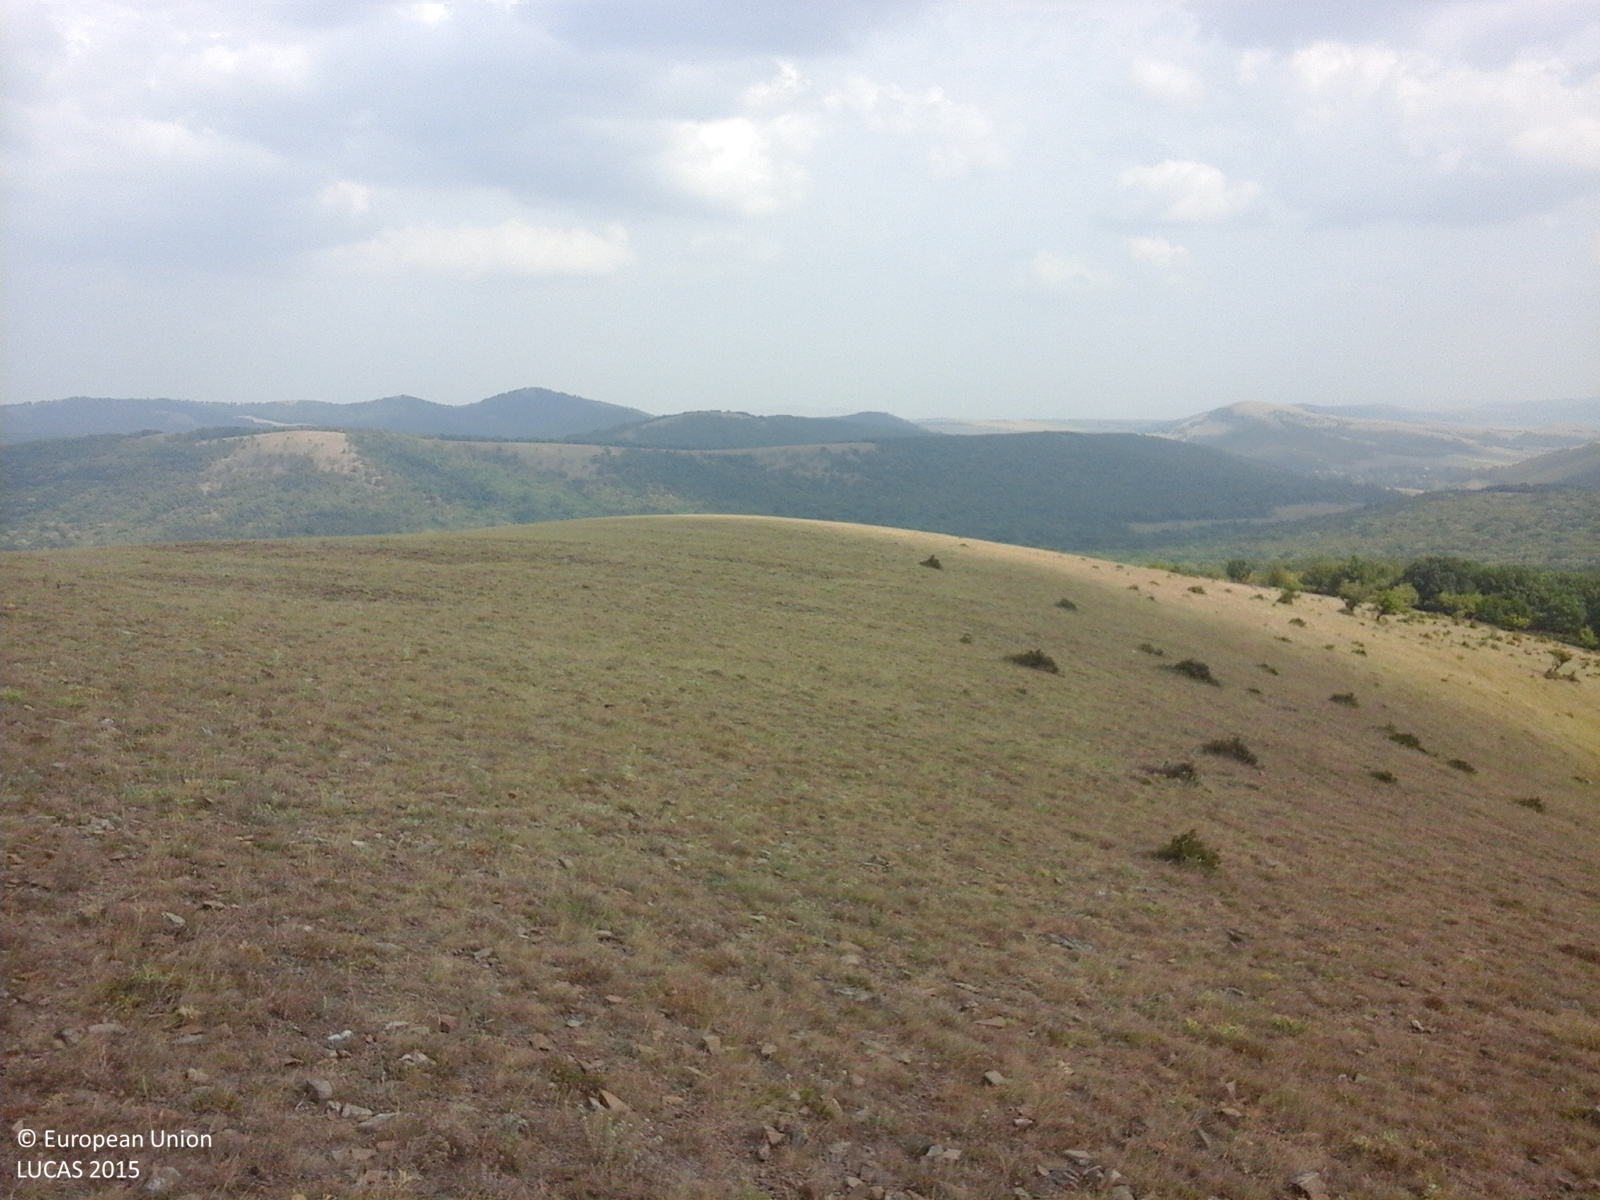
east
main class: Grassland
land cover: Grassland without tree/shrub cover
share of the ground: > 75 %
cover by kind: herbaceous plants 80 %, unconsolidated bare surface 20 %
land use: Agriculture (excluding fallow land and kitchen gardens)
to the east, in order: Grassland without tree/shrub cover
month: July
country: RO
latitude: 45.0901
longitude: 28.4893
